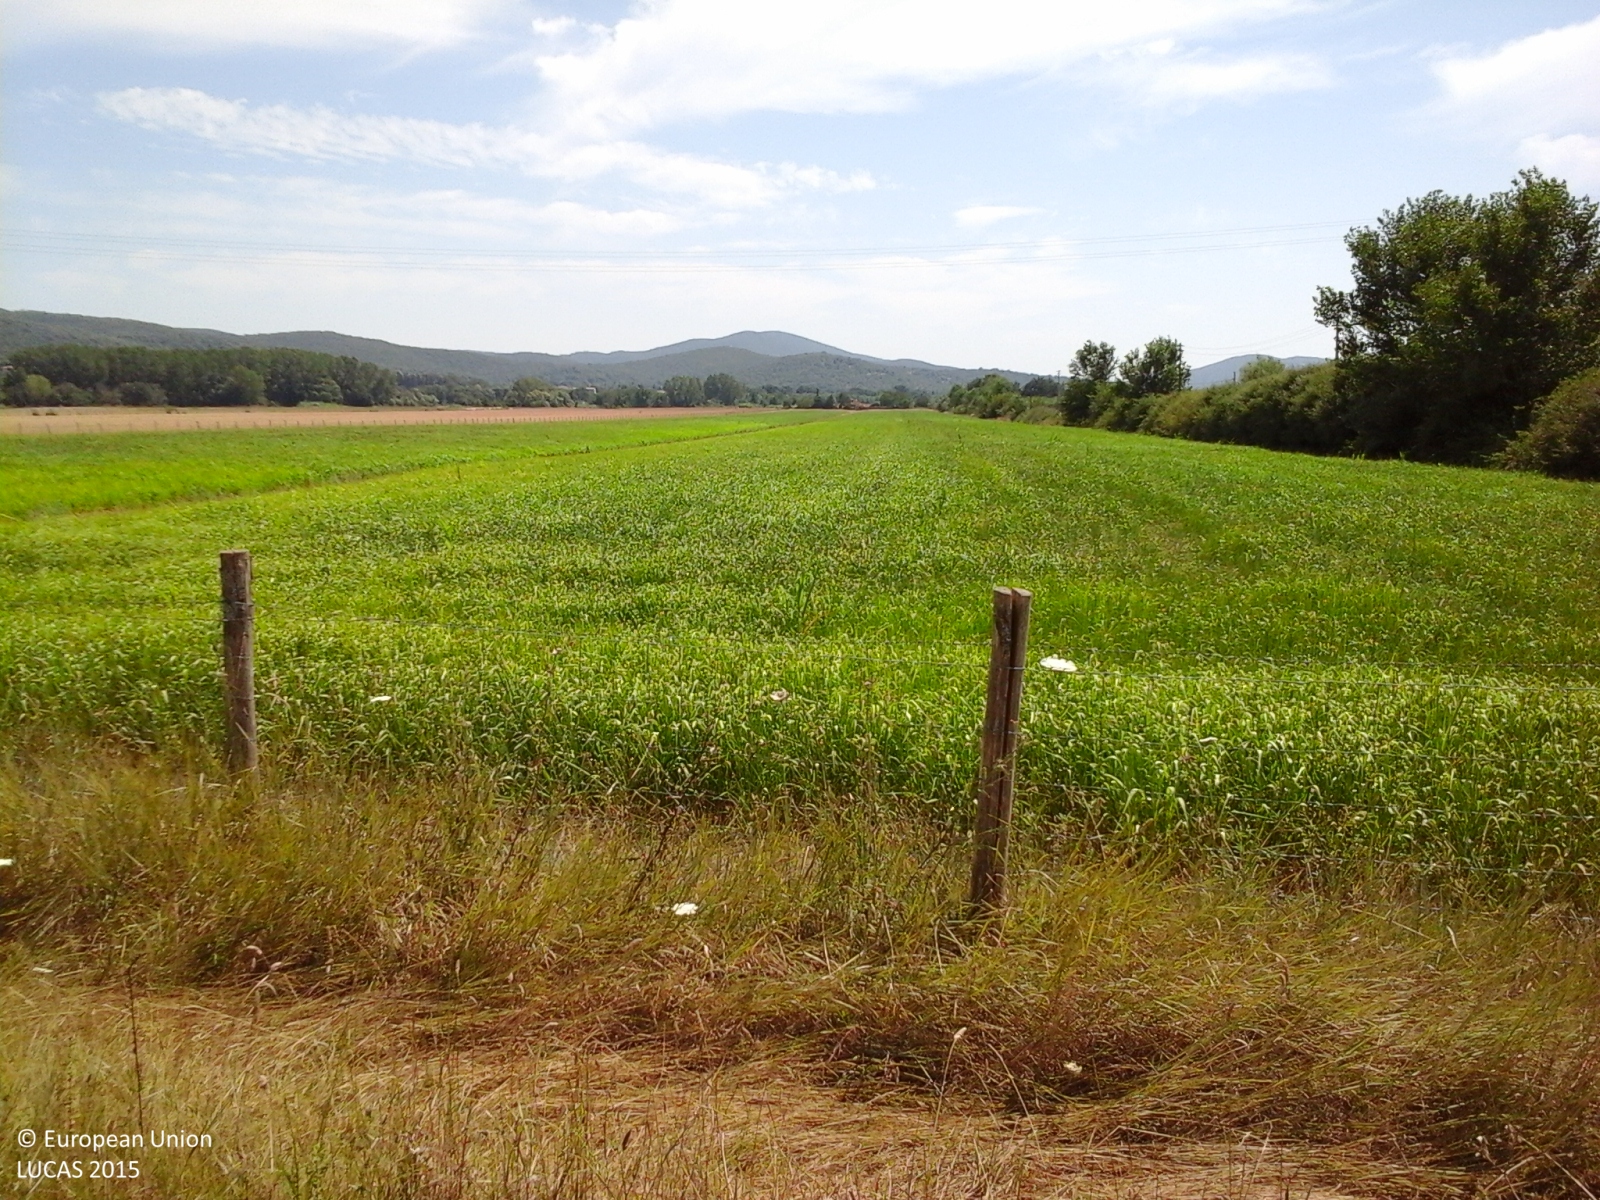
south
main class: Cropland
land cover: Temporary grasslands
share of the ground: > 75 %
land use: Agriculture (excluding fallow land and kitchen gardens)
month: July
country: IT
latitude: 42.9369
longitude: 11.1116
